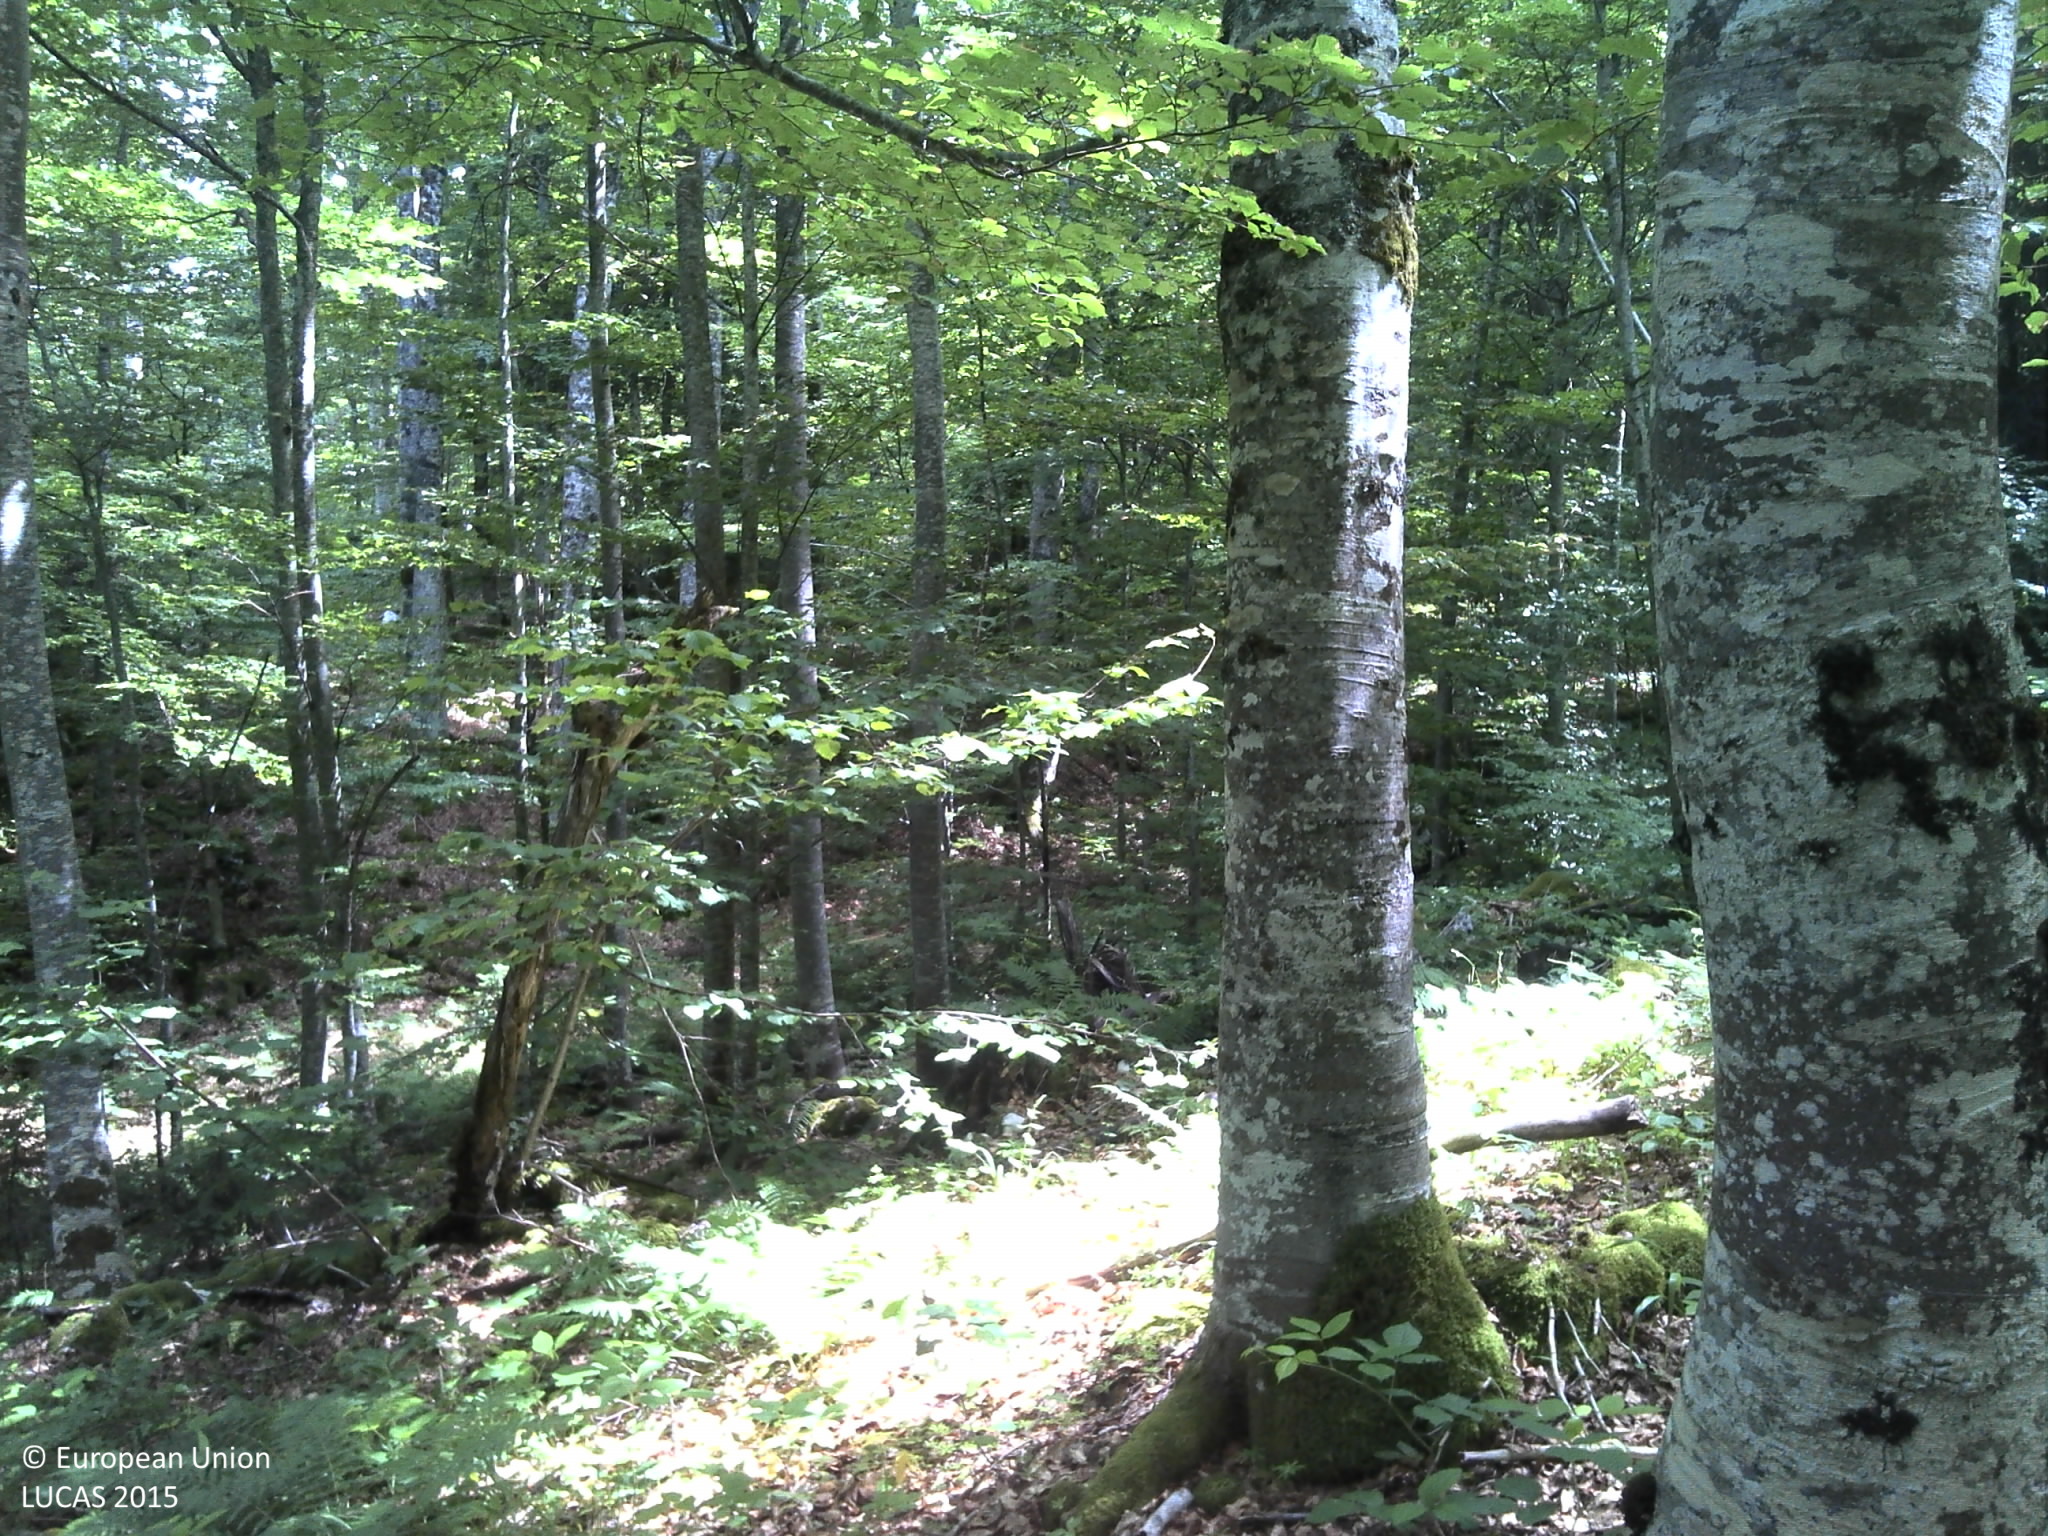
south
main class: Woodland
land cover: Broadleaved woodland
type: mountainous beech forest
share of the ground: > 75 %
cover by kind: broadleaved forest trees 90 %, shrubs 5 %, unconsolidated bare surface 5 %
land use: Forestry
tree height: > 5 m
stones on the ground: < 10 %
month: June
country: HR
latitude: 44.6177
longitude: 15.8794
